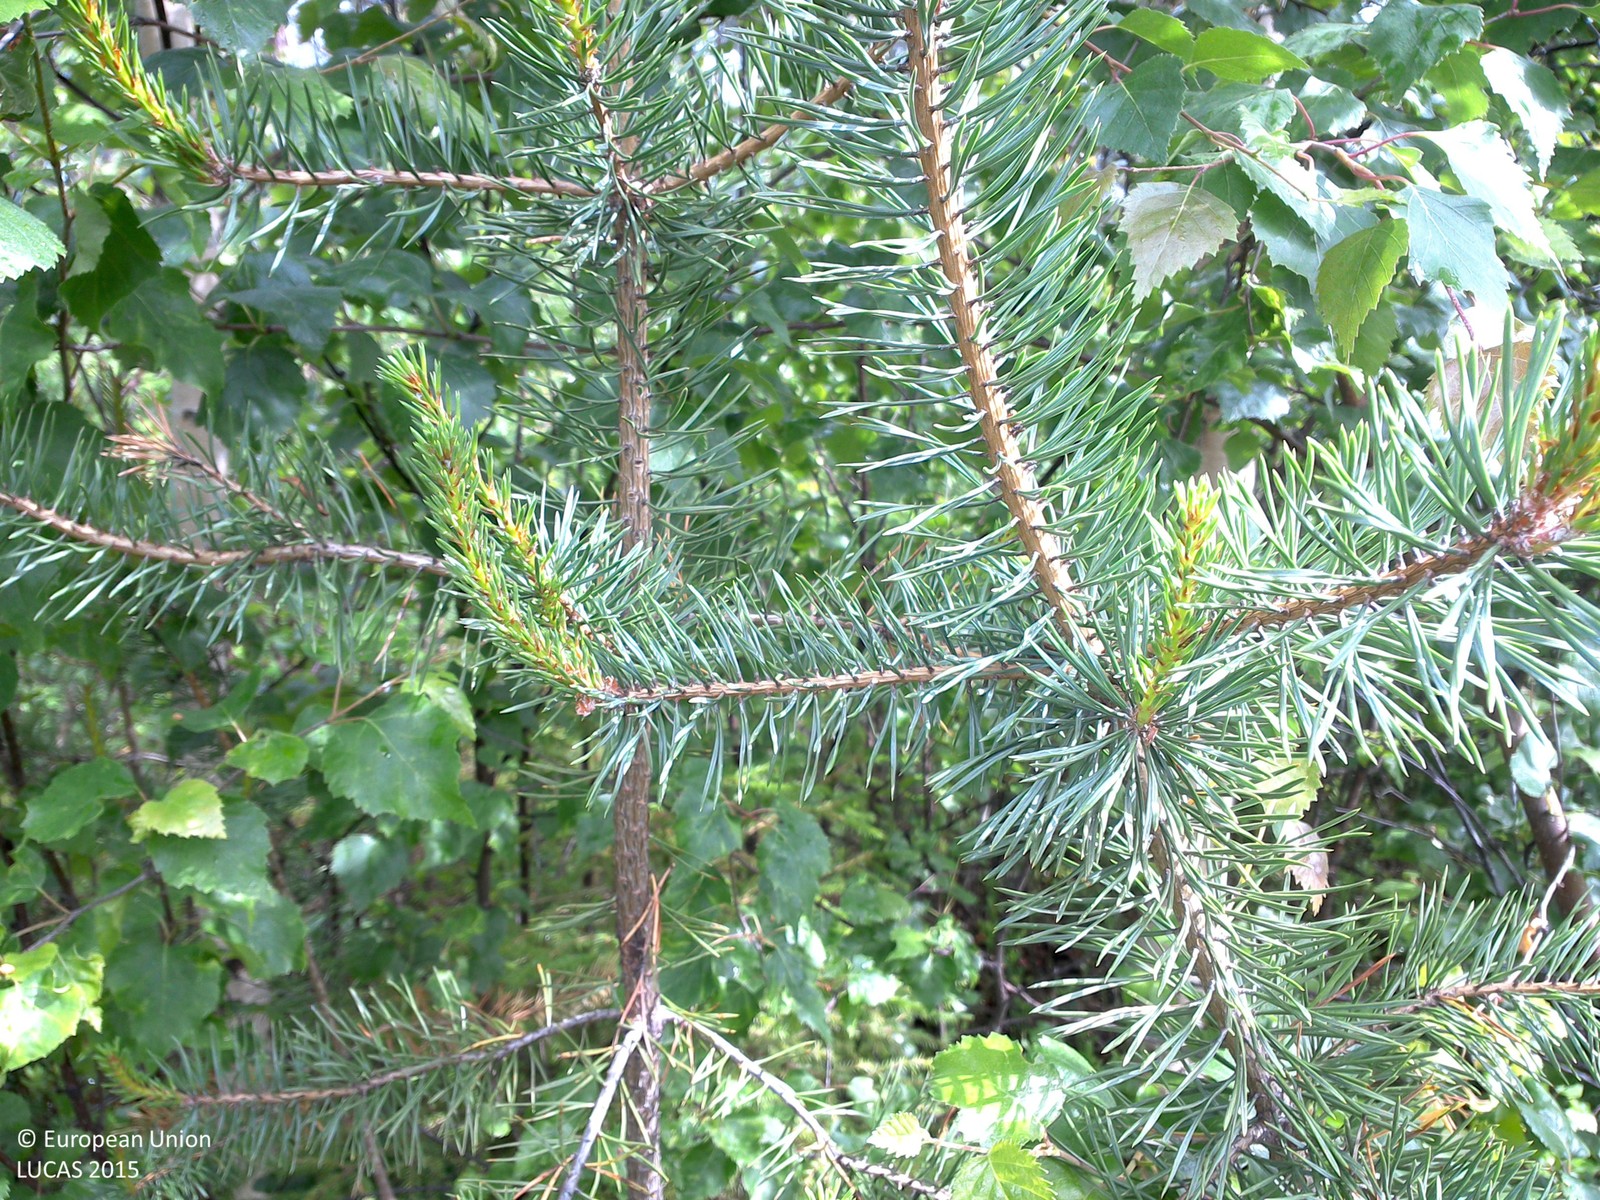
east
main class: Woodland
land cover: Other mixed woodland
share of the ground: 50 - 75 %
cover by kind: broadleaved forest trees 50 %, shrubs 30 %, coniferous forest trees 20 %
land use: Forestry
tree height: > 5 m
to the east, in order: Grass margins; Other mixed woodland; Pine dominated mixed woodland; Ditches and canals; Grassland without tree/shrub cover; Spruce dominated mixed woodland; Ditches and canals; Spruce dominated mixed woodland; Pine dominated mixed woodland
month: July
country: SE
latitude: 66.8763
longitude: 23.9269
